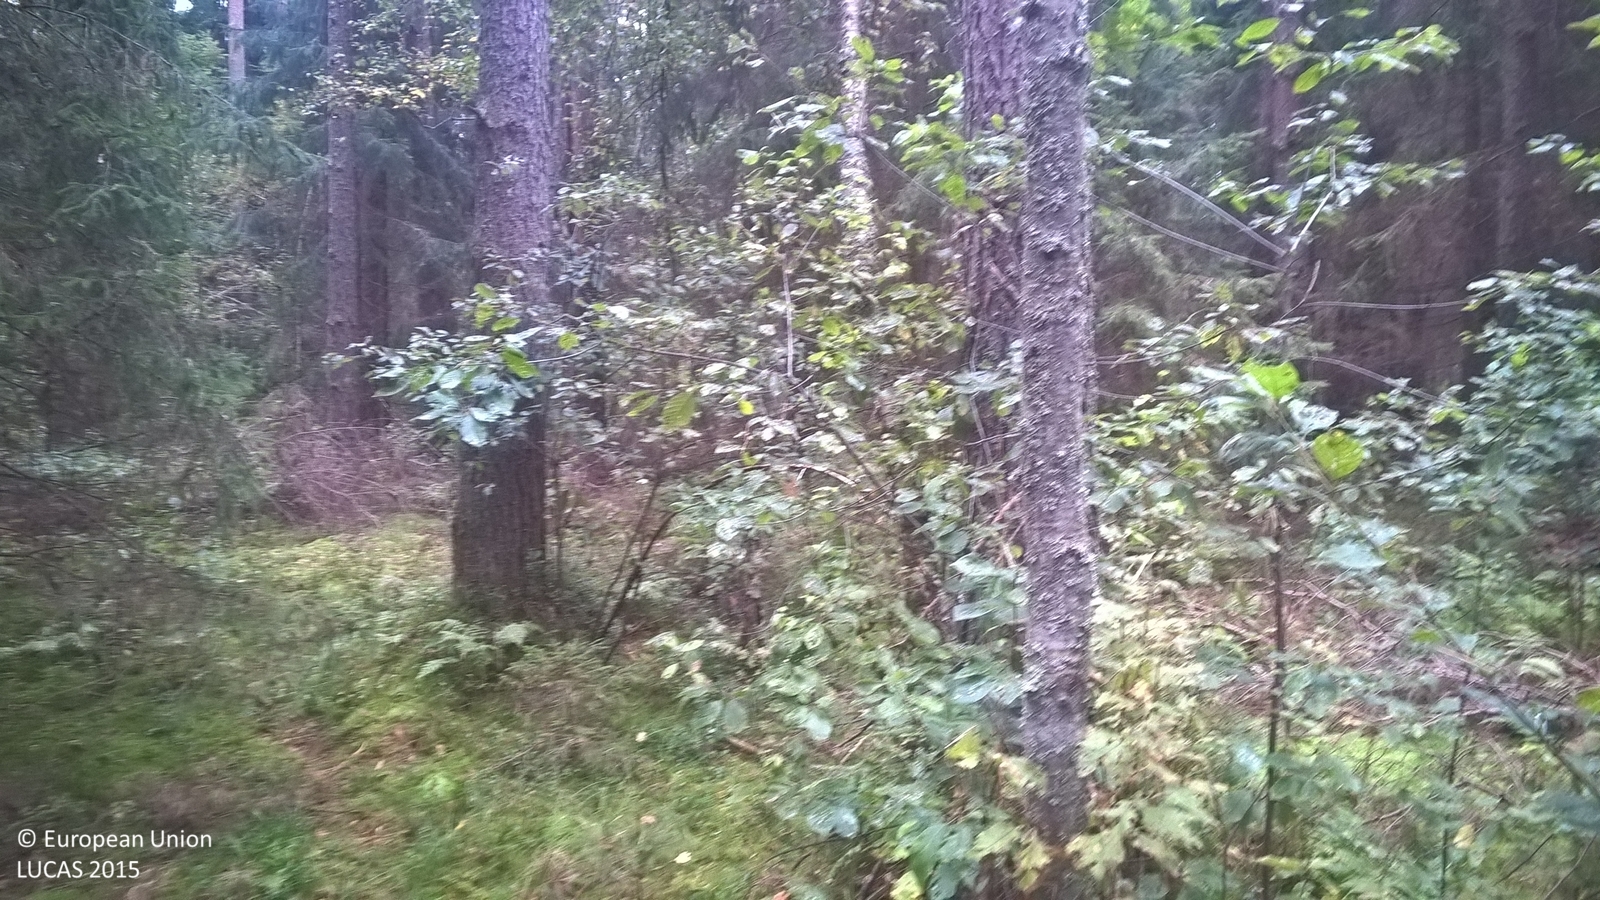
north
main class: Woodland
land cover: Other coniferous woodland
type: hemiboreal forest and nemoral coniferous forest and mixed broadleaved-coniferous forest
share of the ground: > 75 %
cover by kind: coniferous forest trees 75 %, broadleaved forest trees 10 %, herbaceous plants 10 %, shrubs 5 %
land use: Forestry
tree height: > 5 m
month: September
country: LV
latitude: 57.5172
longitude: 25.6280
